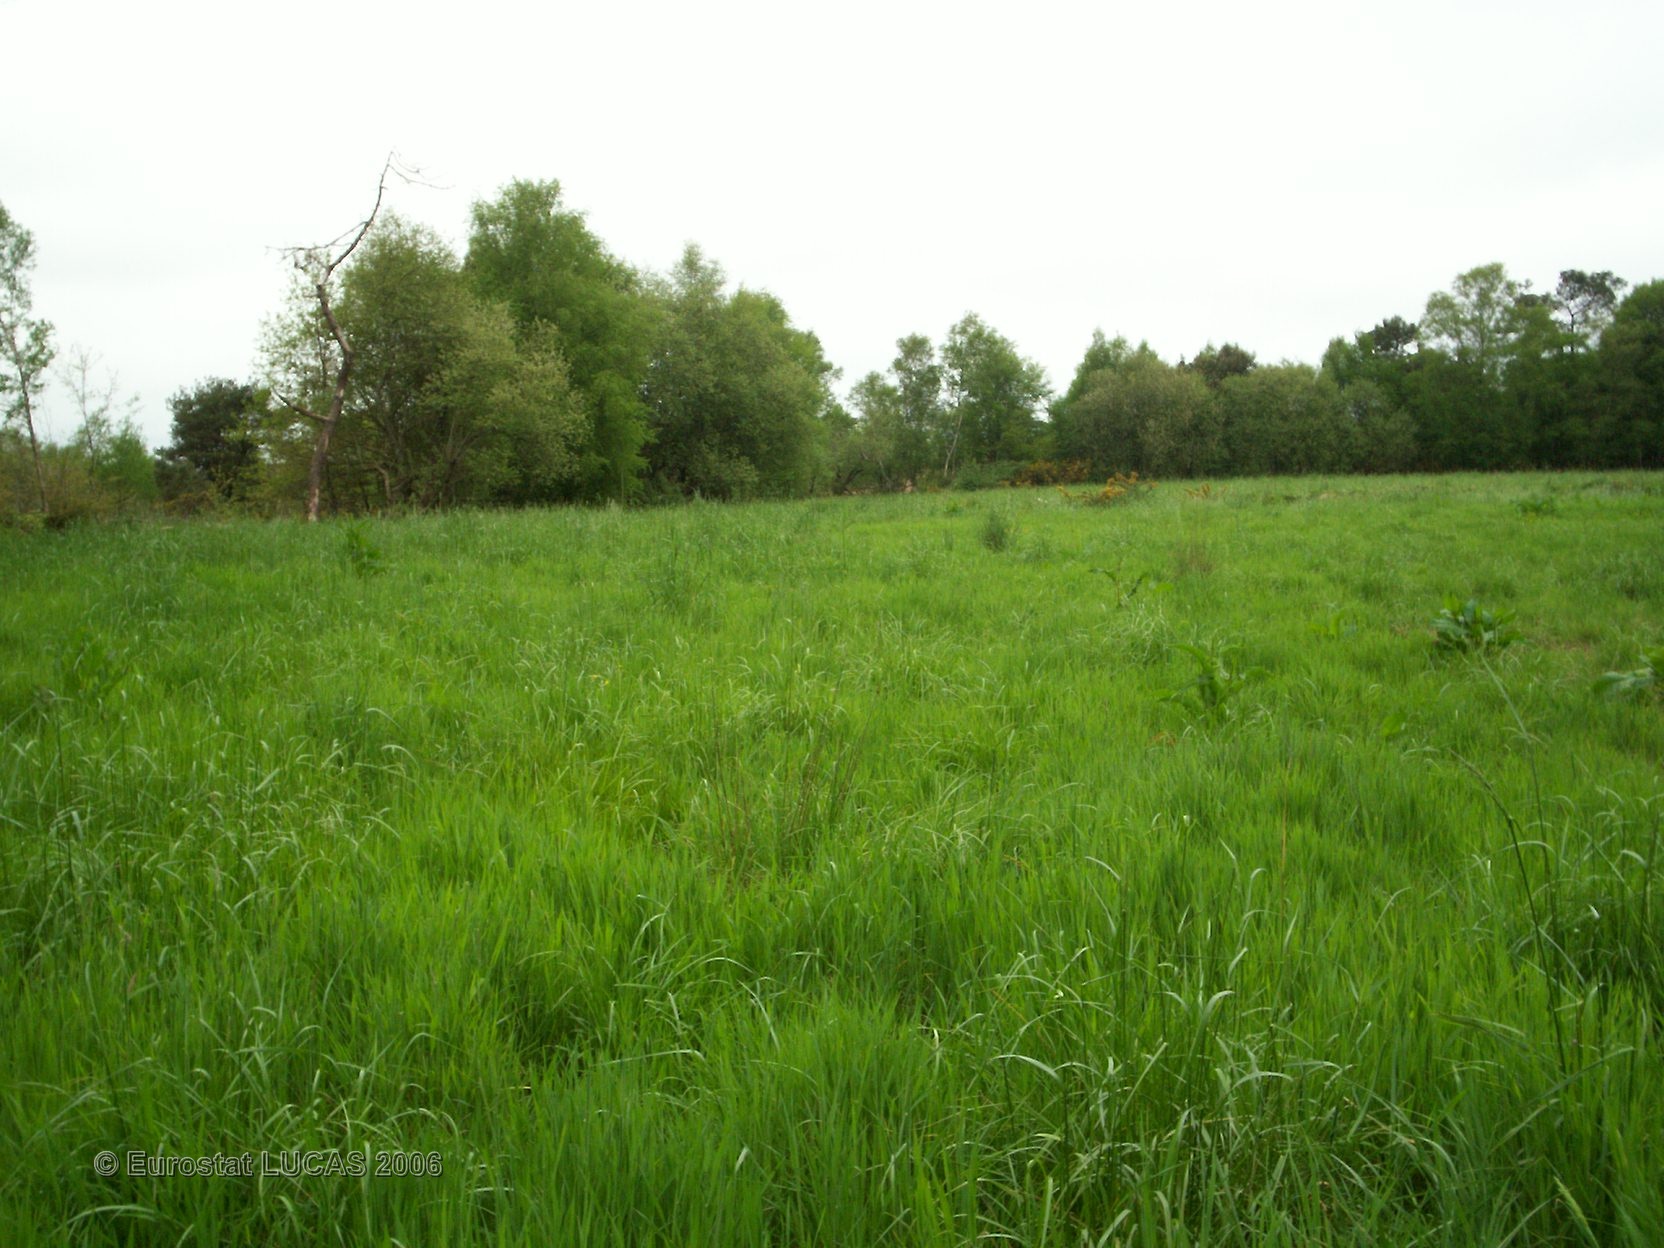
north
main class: Grassland
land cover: Grassland without tree/shrub cover
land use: Agriculture (excluding fallow land and kitchen gardens)
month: May
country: FR
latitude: 48.2254
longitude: -2.7587
